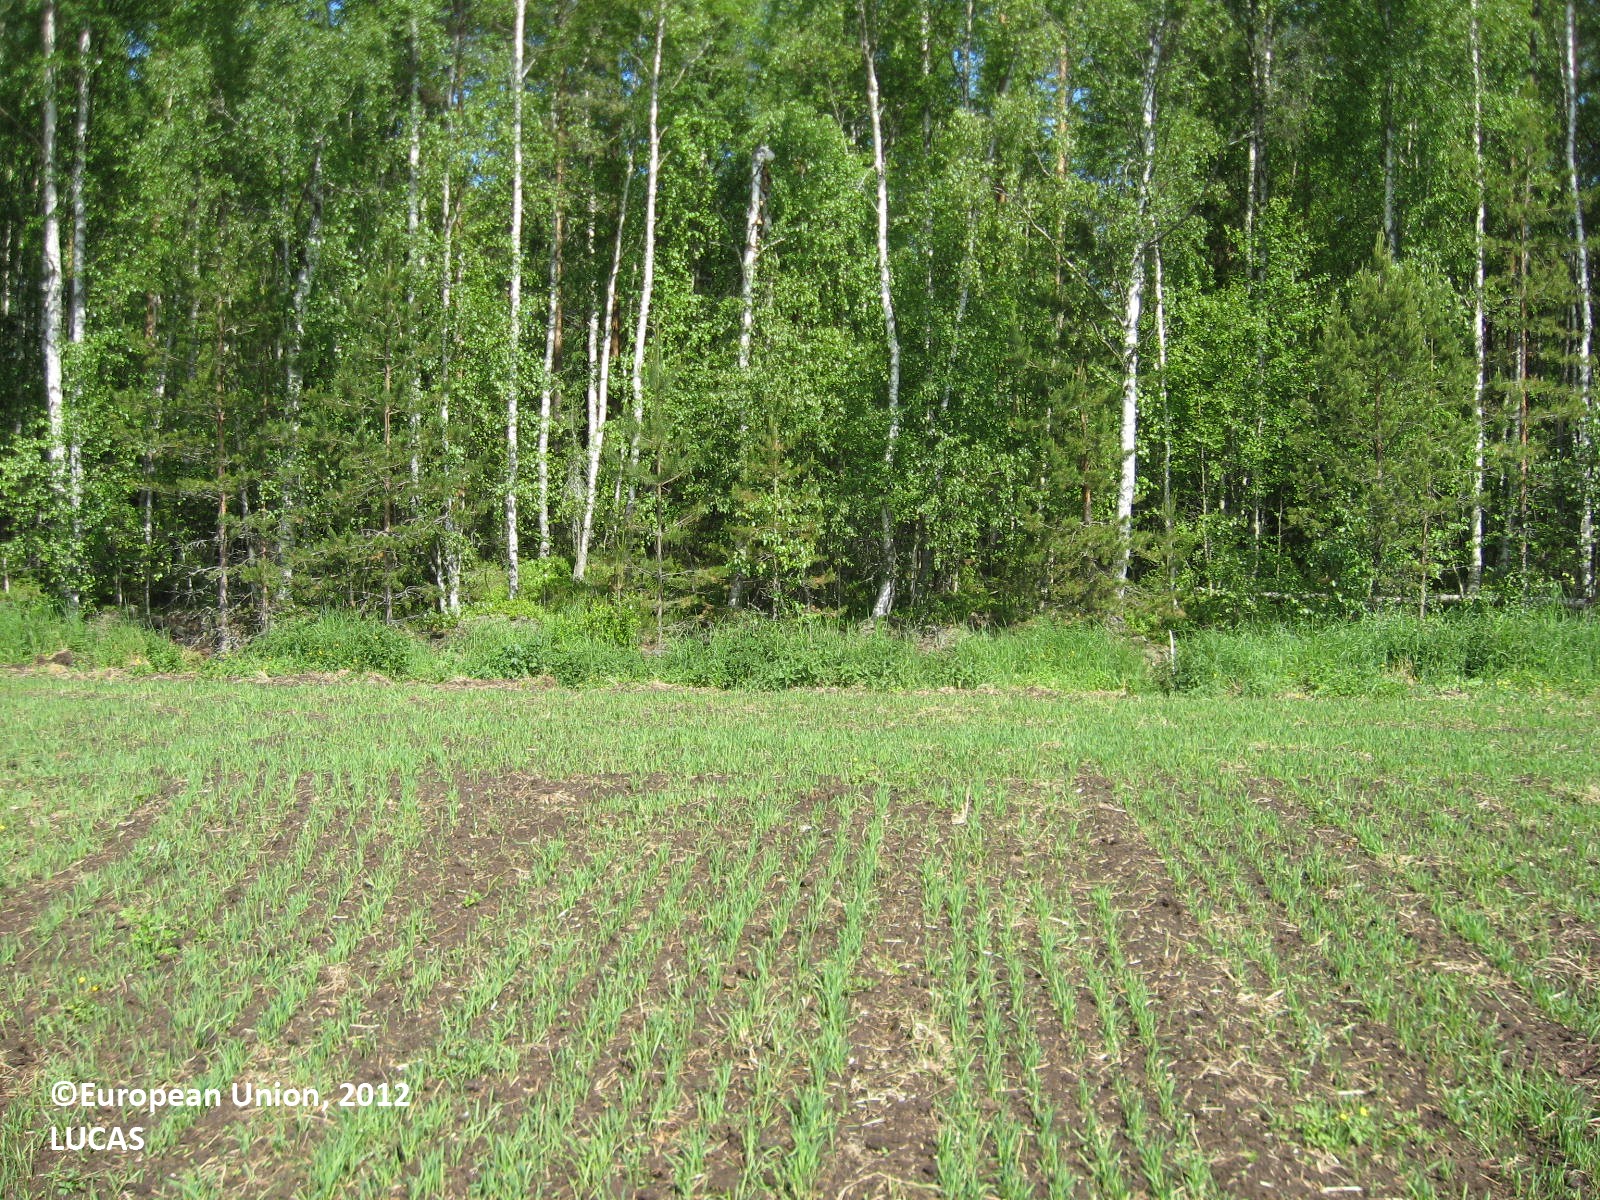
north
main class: Cropland
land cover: Oats
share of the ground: 50 - 75 %
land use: Agriculture (excluding fallow land and kitchen gardens)
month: June
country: FI
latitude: 62.8374
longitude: 21.8451
